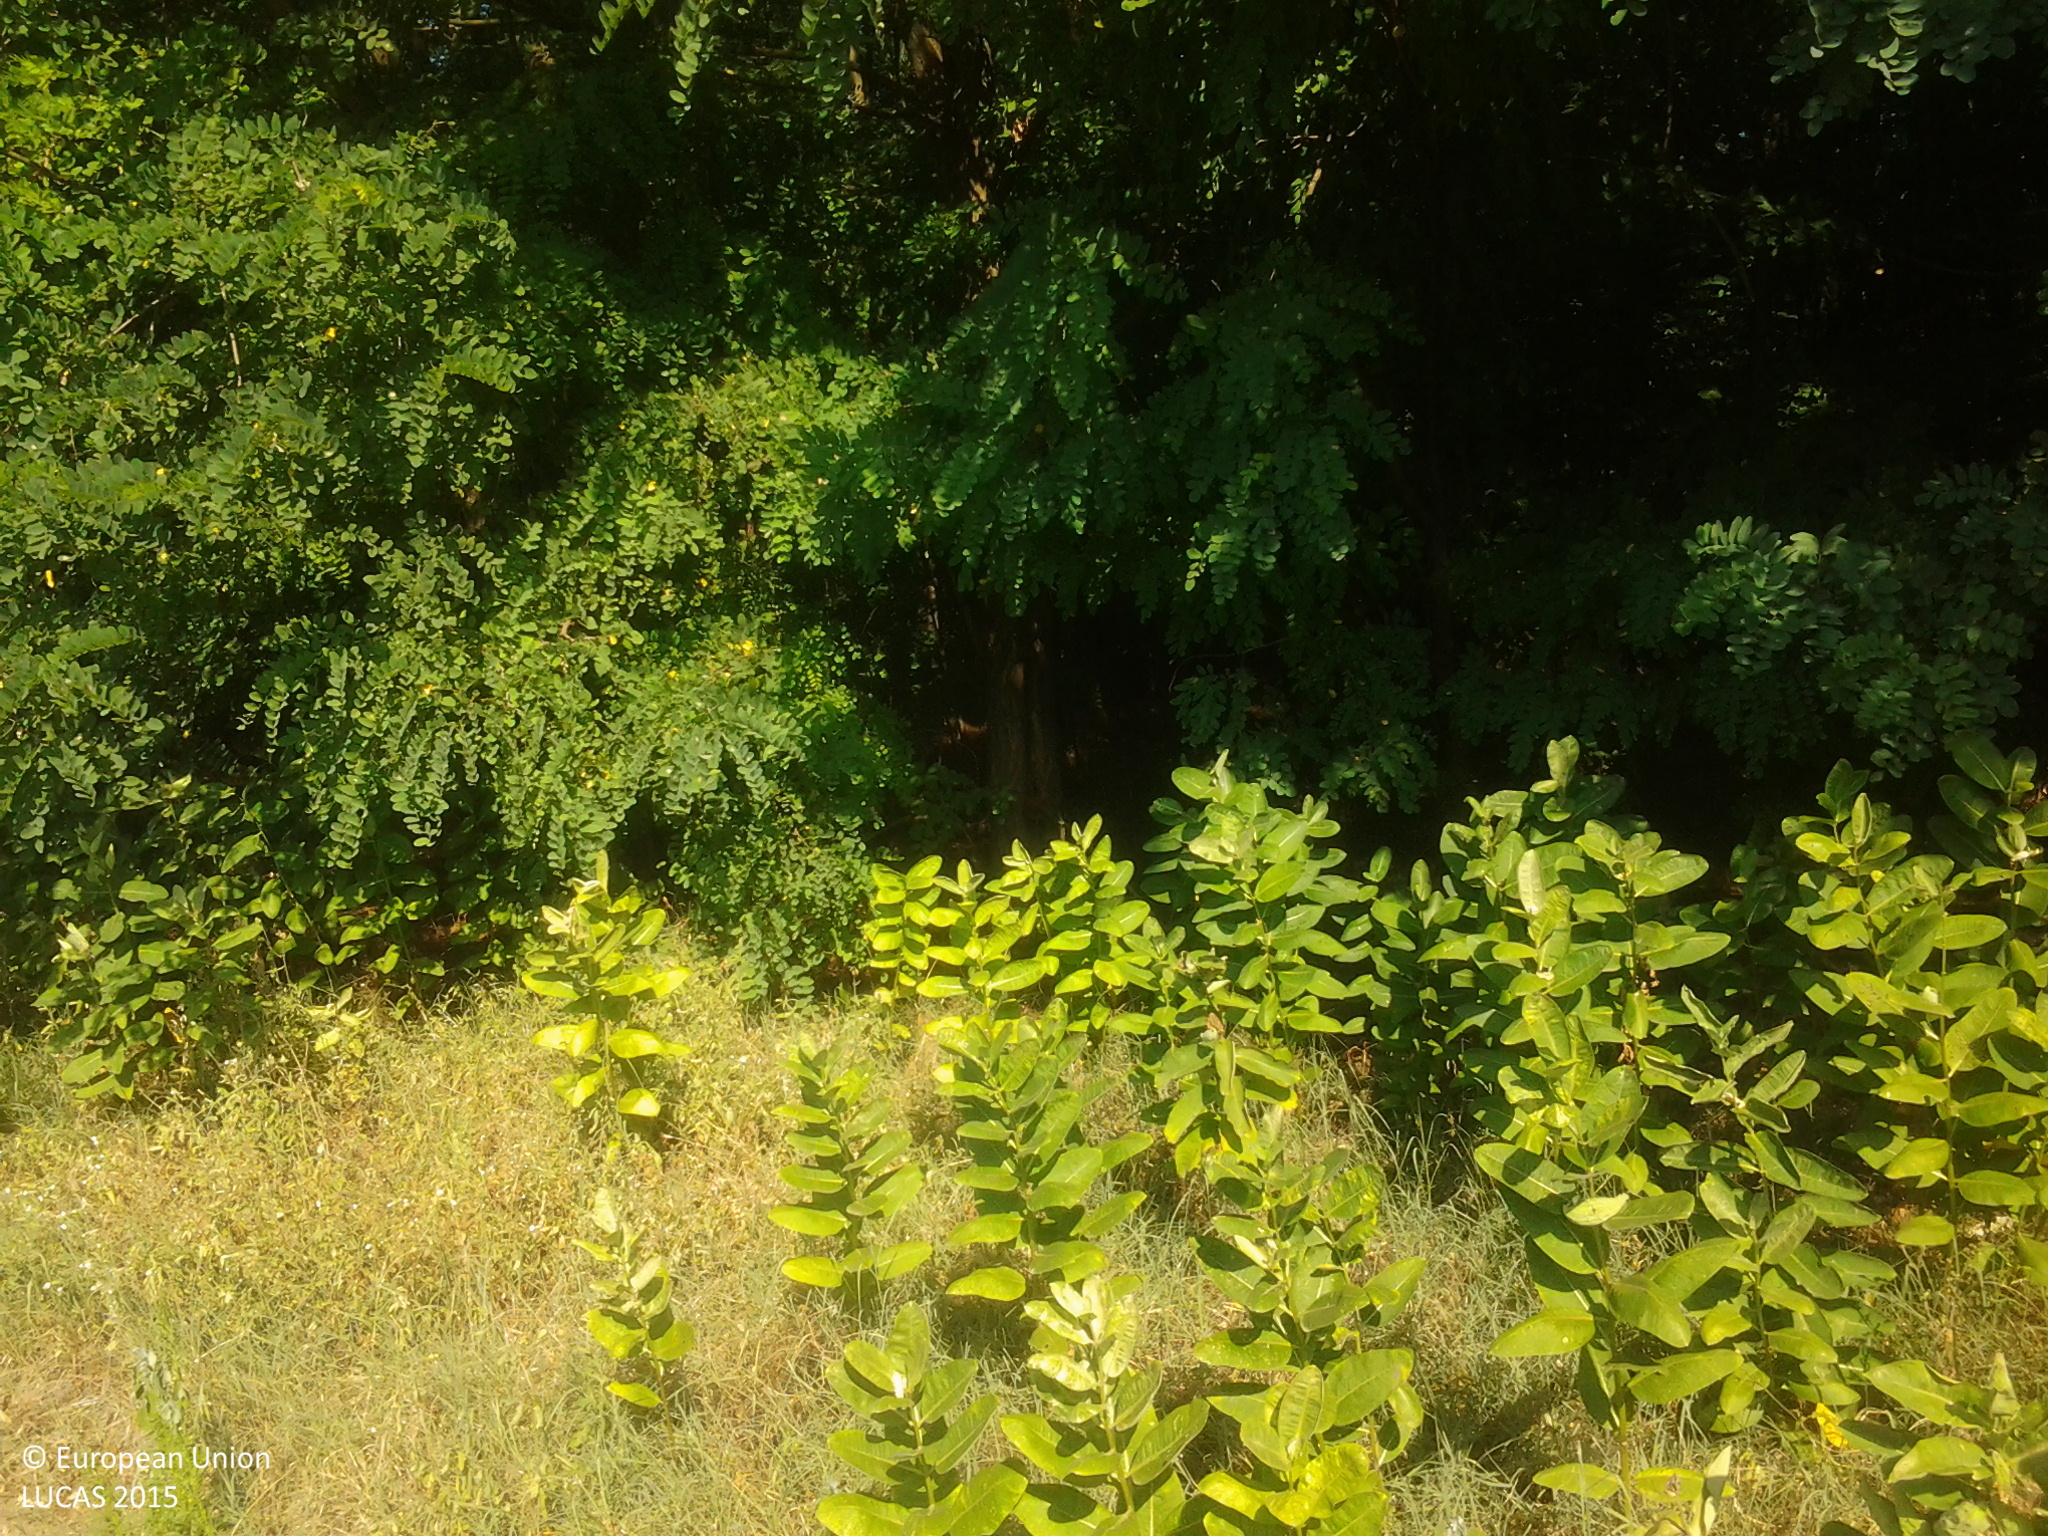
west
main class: Grassland
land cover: Spontaneously vegetated surfaces
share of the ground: 50 - 75 %
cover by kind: herbaceous plants 65 %, unconsolidated bare surface 35 %
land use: Forestry
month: July
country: HU
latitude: 46.5132
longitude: 19.2300
